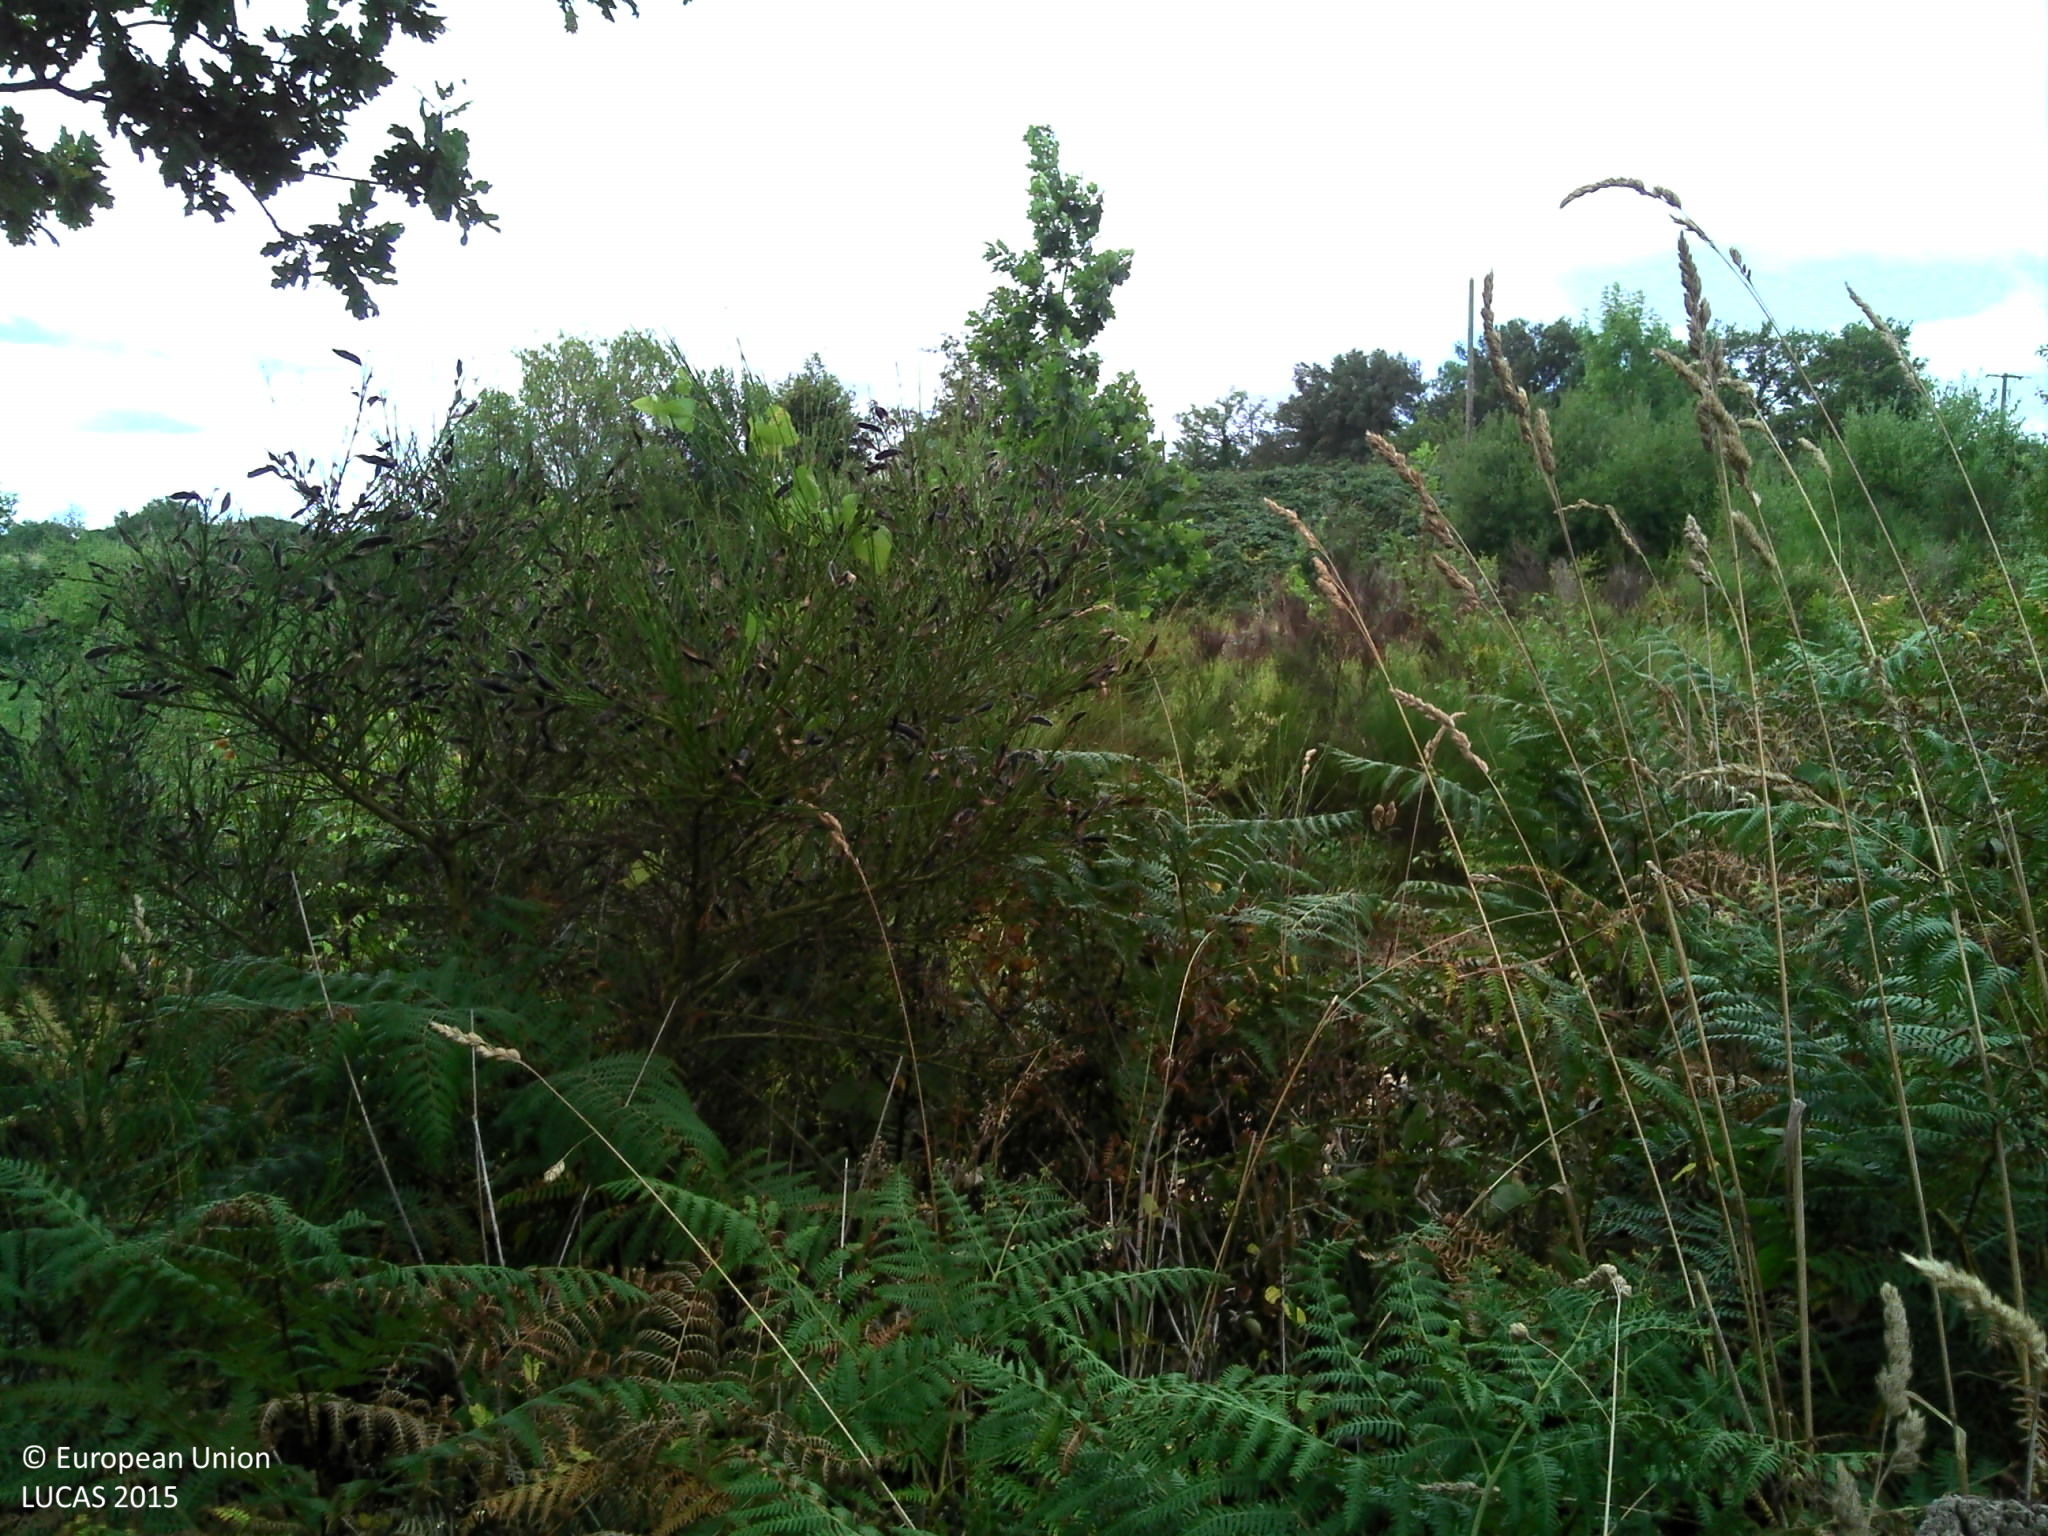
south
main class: Grassland
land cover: Grassland without tree/shrub cover
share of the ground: > 75 %
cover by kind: herbaceous plants 100 %
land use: Agriculture (excluding fallow land and kitchen gardens)
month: July
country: FR
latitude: 44.0448
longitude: 2.5289
